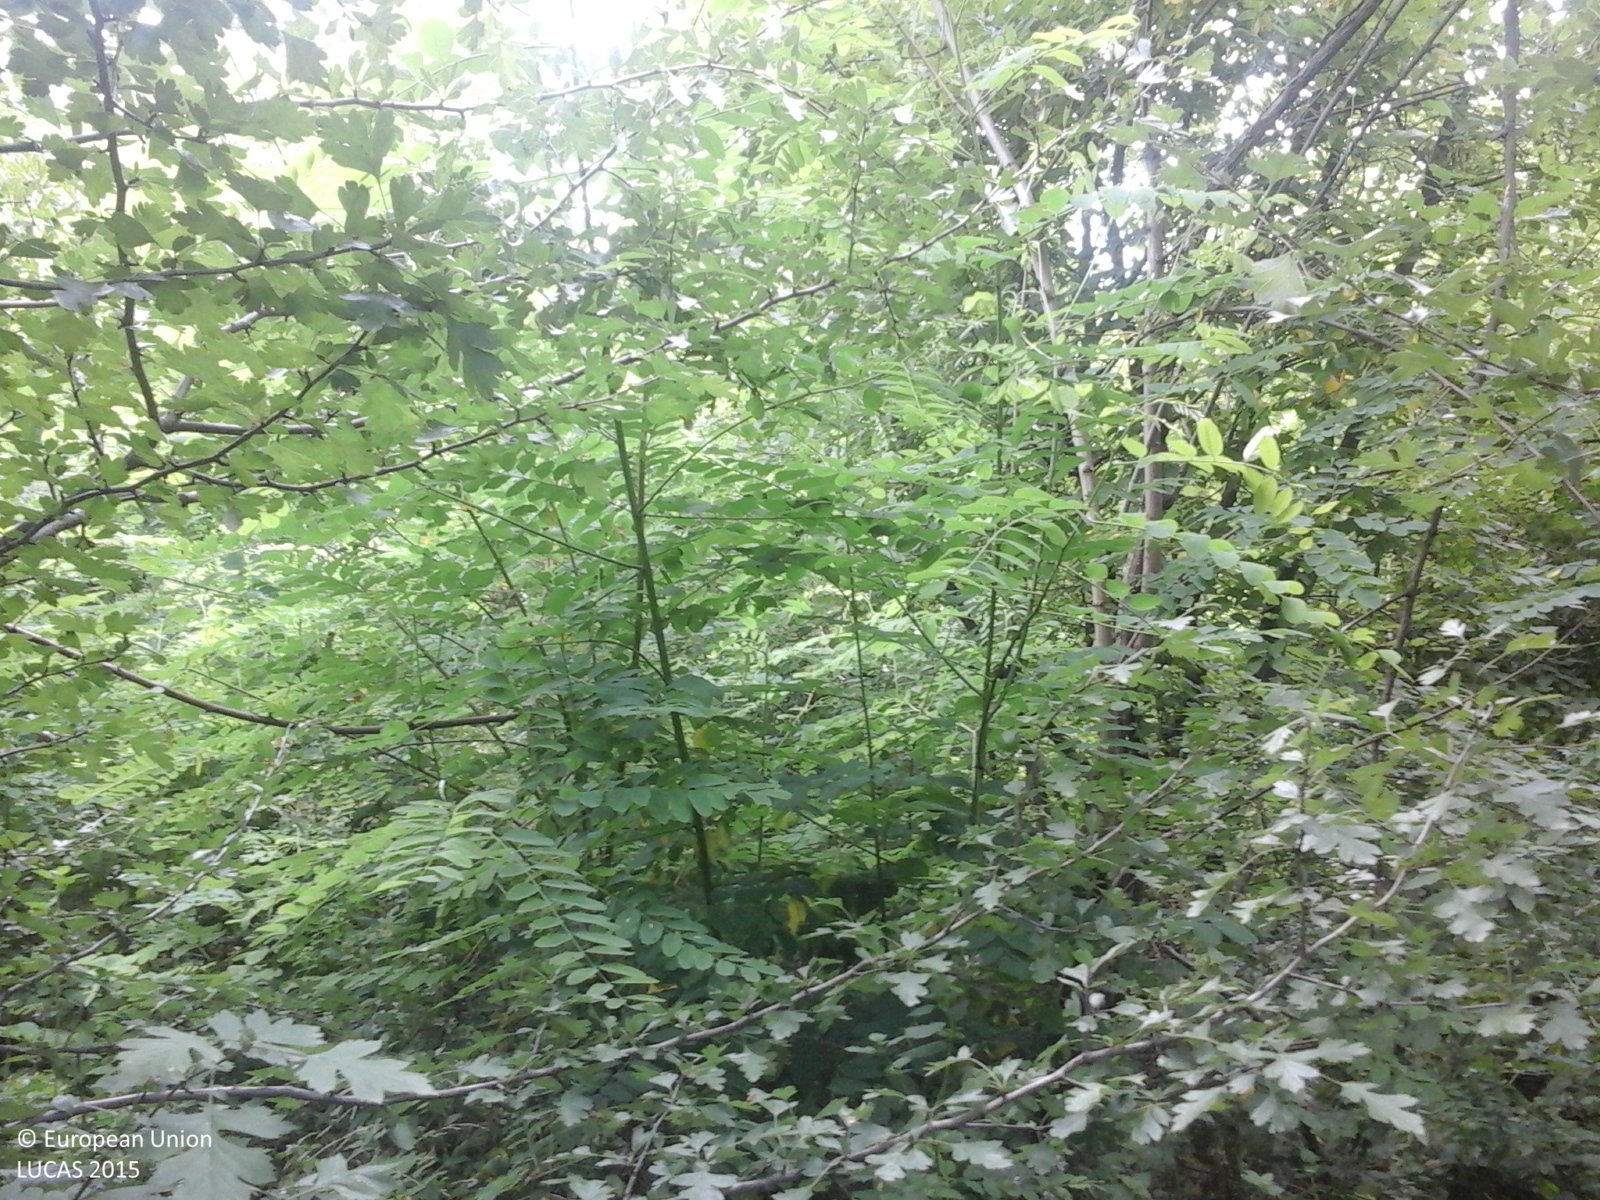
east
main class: Cropland
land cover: Maize
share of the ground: > 75 %
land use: Agriculture (excluding fallow land and kitchen gardens)
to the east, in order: Maize; Grass margins; Tracks; Grass margins; Broadleaved woodland
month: June
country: RO
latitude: 44.3171
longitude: 25.9609
